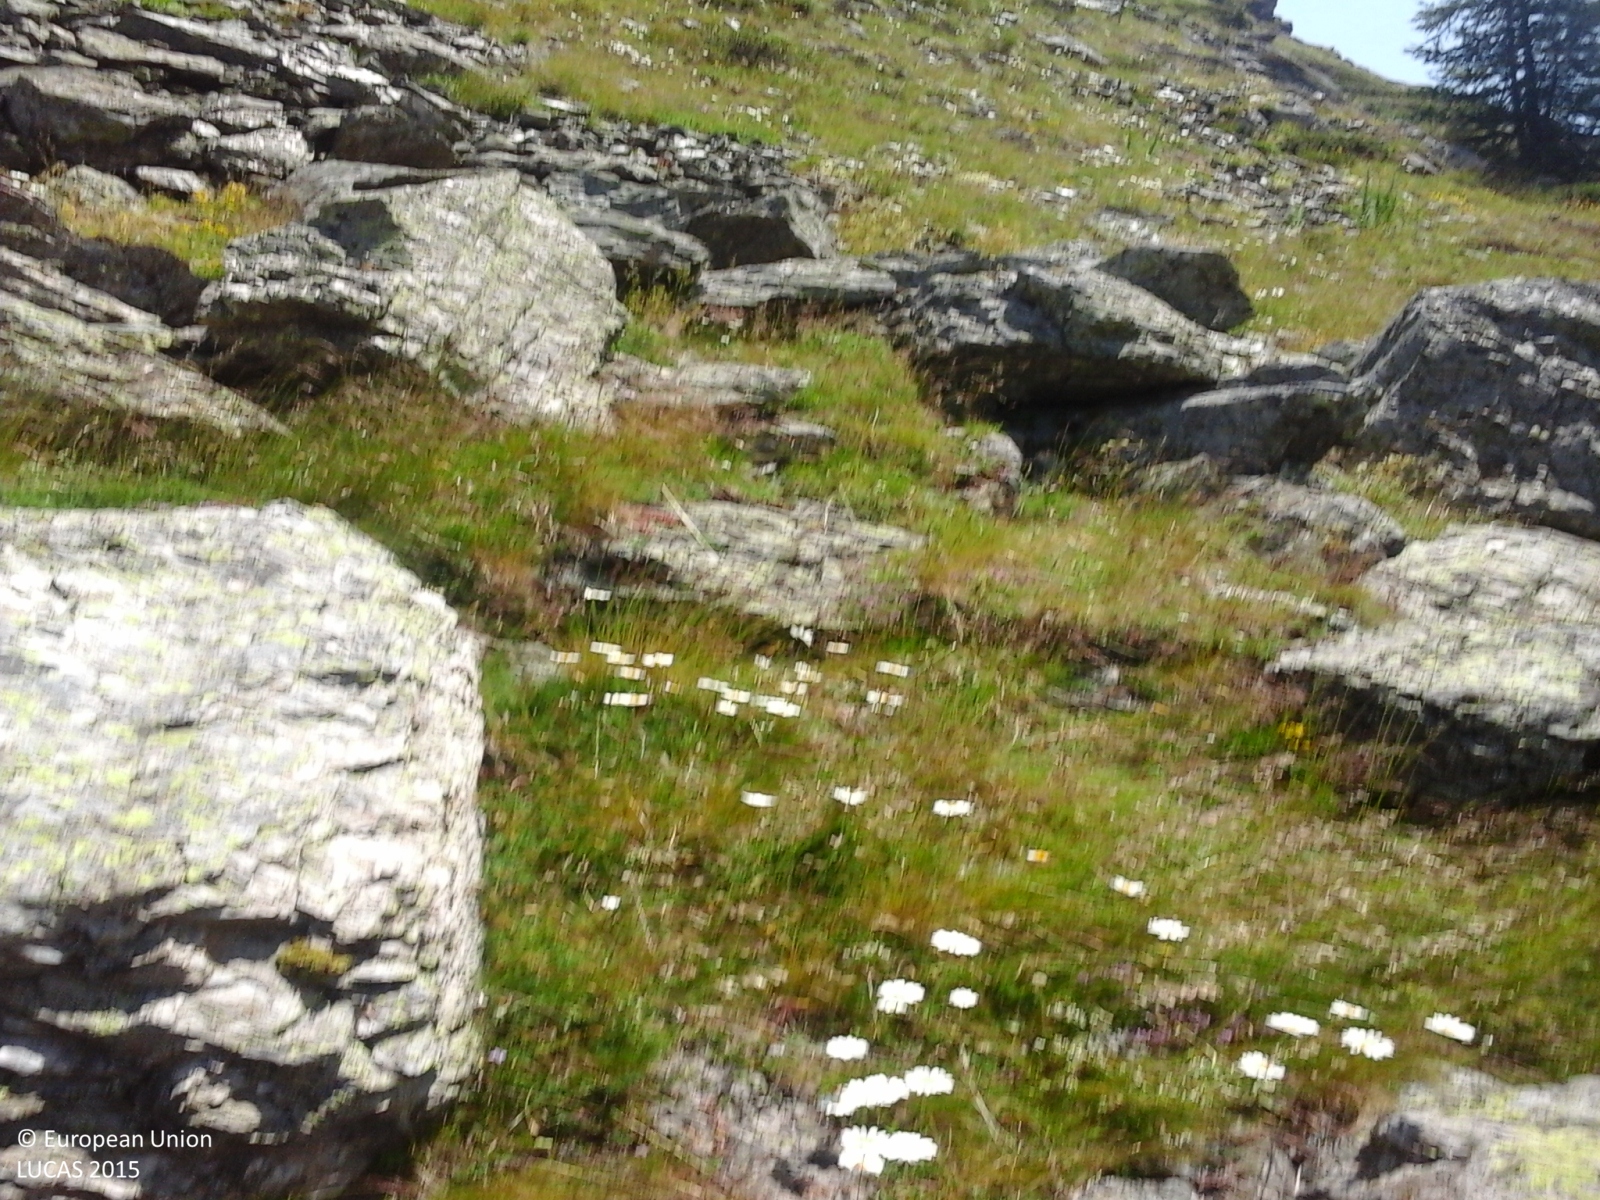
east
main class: Grassland
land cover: Grassland without tree/shrub cover
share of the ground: > 75 %
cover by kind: herbaceous plants 70 %, consolidated bare surface 30 %
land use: Agriculture (excluding fallow land and kitchen gardens)
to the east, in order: Grassland without tree/shrub cover; Rocks and stones; Grassland without tree/shrub cover
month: July
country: IT
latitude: 46.5131
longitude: 10.1952
